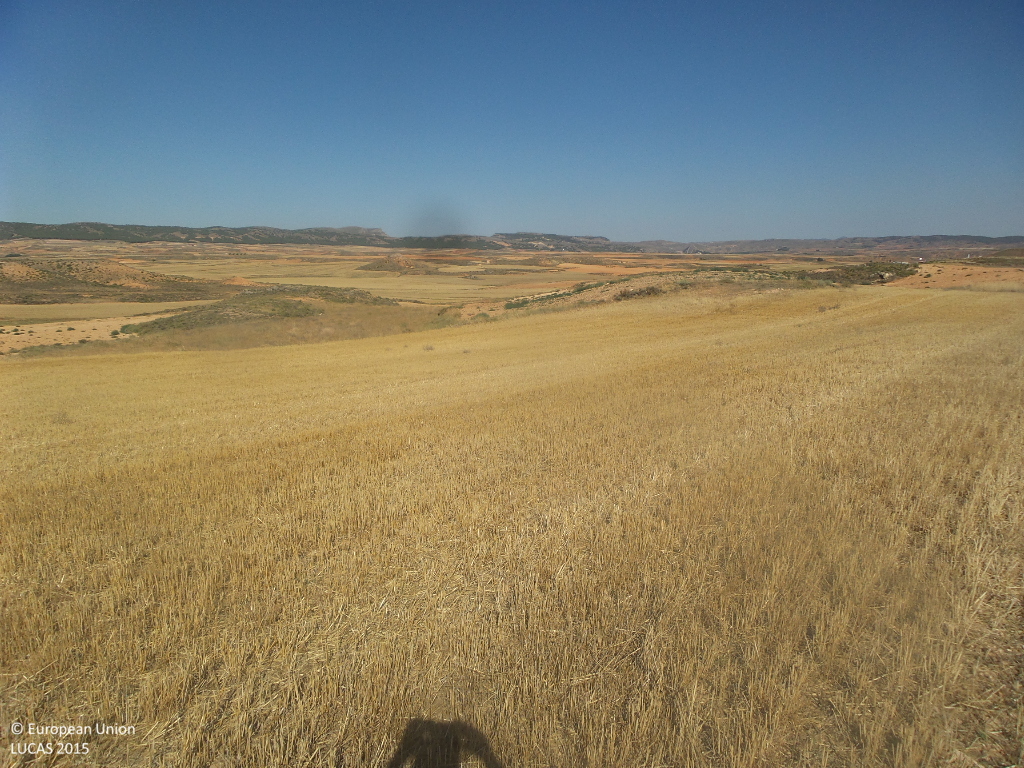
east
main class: Cropland
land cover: Barley
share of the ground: < 10 %
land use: Agriculture (excluding fallow land and kitchen gardens)
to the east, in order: Barley; Grass margins; Shrubland without tree cover; Spontaneously vegetated surfaces; Shrubland without tree cover; Other bare soil; Shrubland without tree cover; Other bare soil
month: July
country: ES
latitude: 41.3192
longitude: -1.9864
